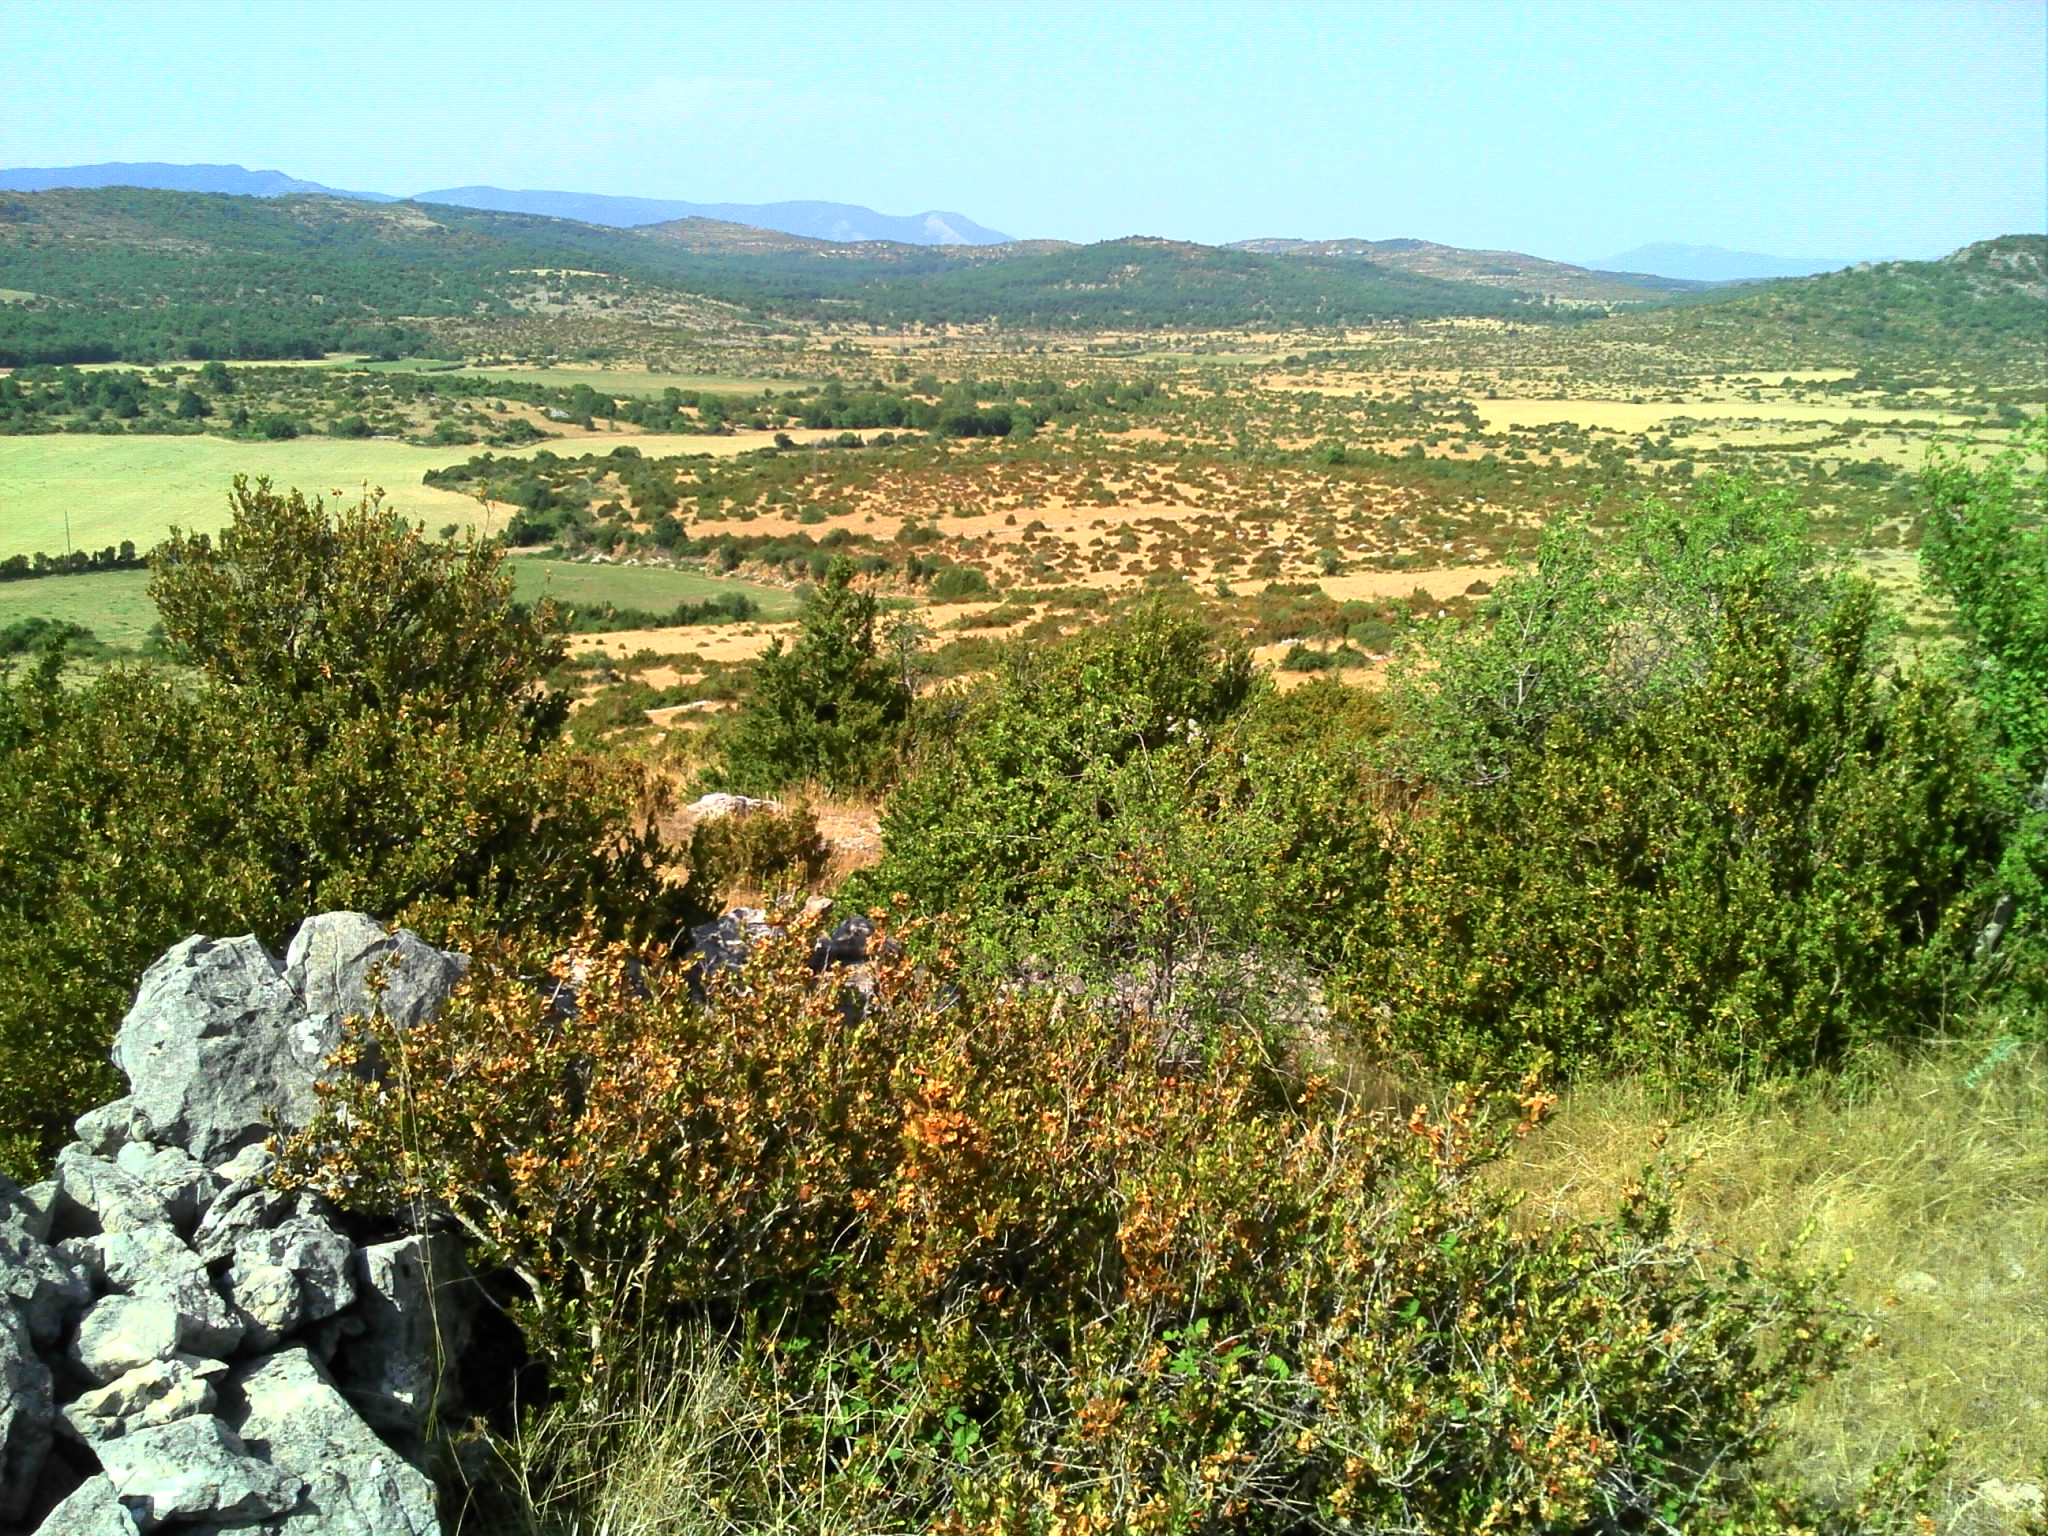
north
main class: Shrubland
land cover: Shrubland without tree cover
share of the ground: > 75 %
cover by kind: shrubs 40 %, herbaceous plants 40 %, consolidated bare surface 20 %
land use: Agriculture (excluding fallow land and kitchen gardens)
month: July
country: FR
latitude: 43.9128
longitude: 3.5197
